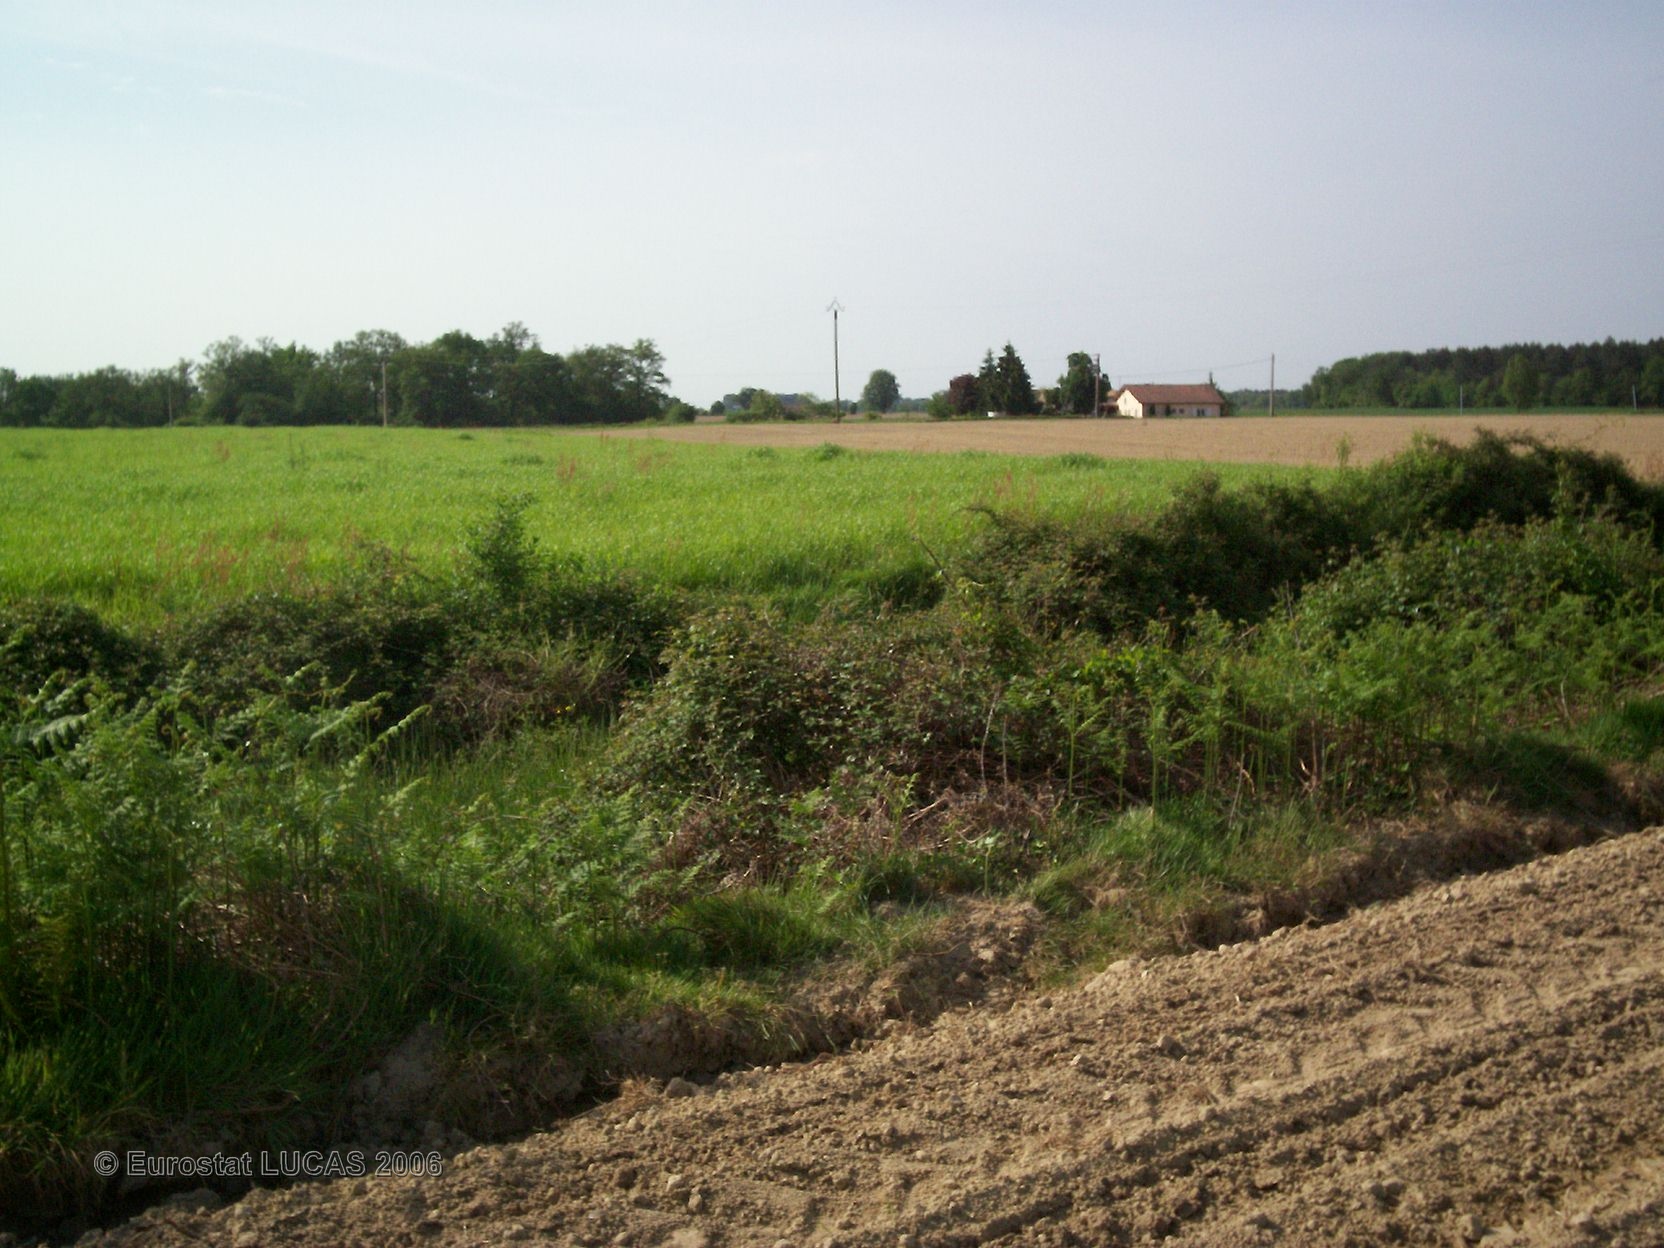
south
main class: Cropland
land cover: Maize
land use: Agriculture (excluding fallow land and kitchen gardens)
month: June
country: FR
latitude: 43.7380
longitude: -0.3775
